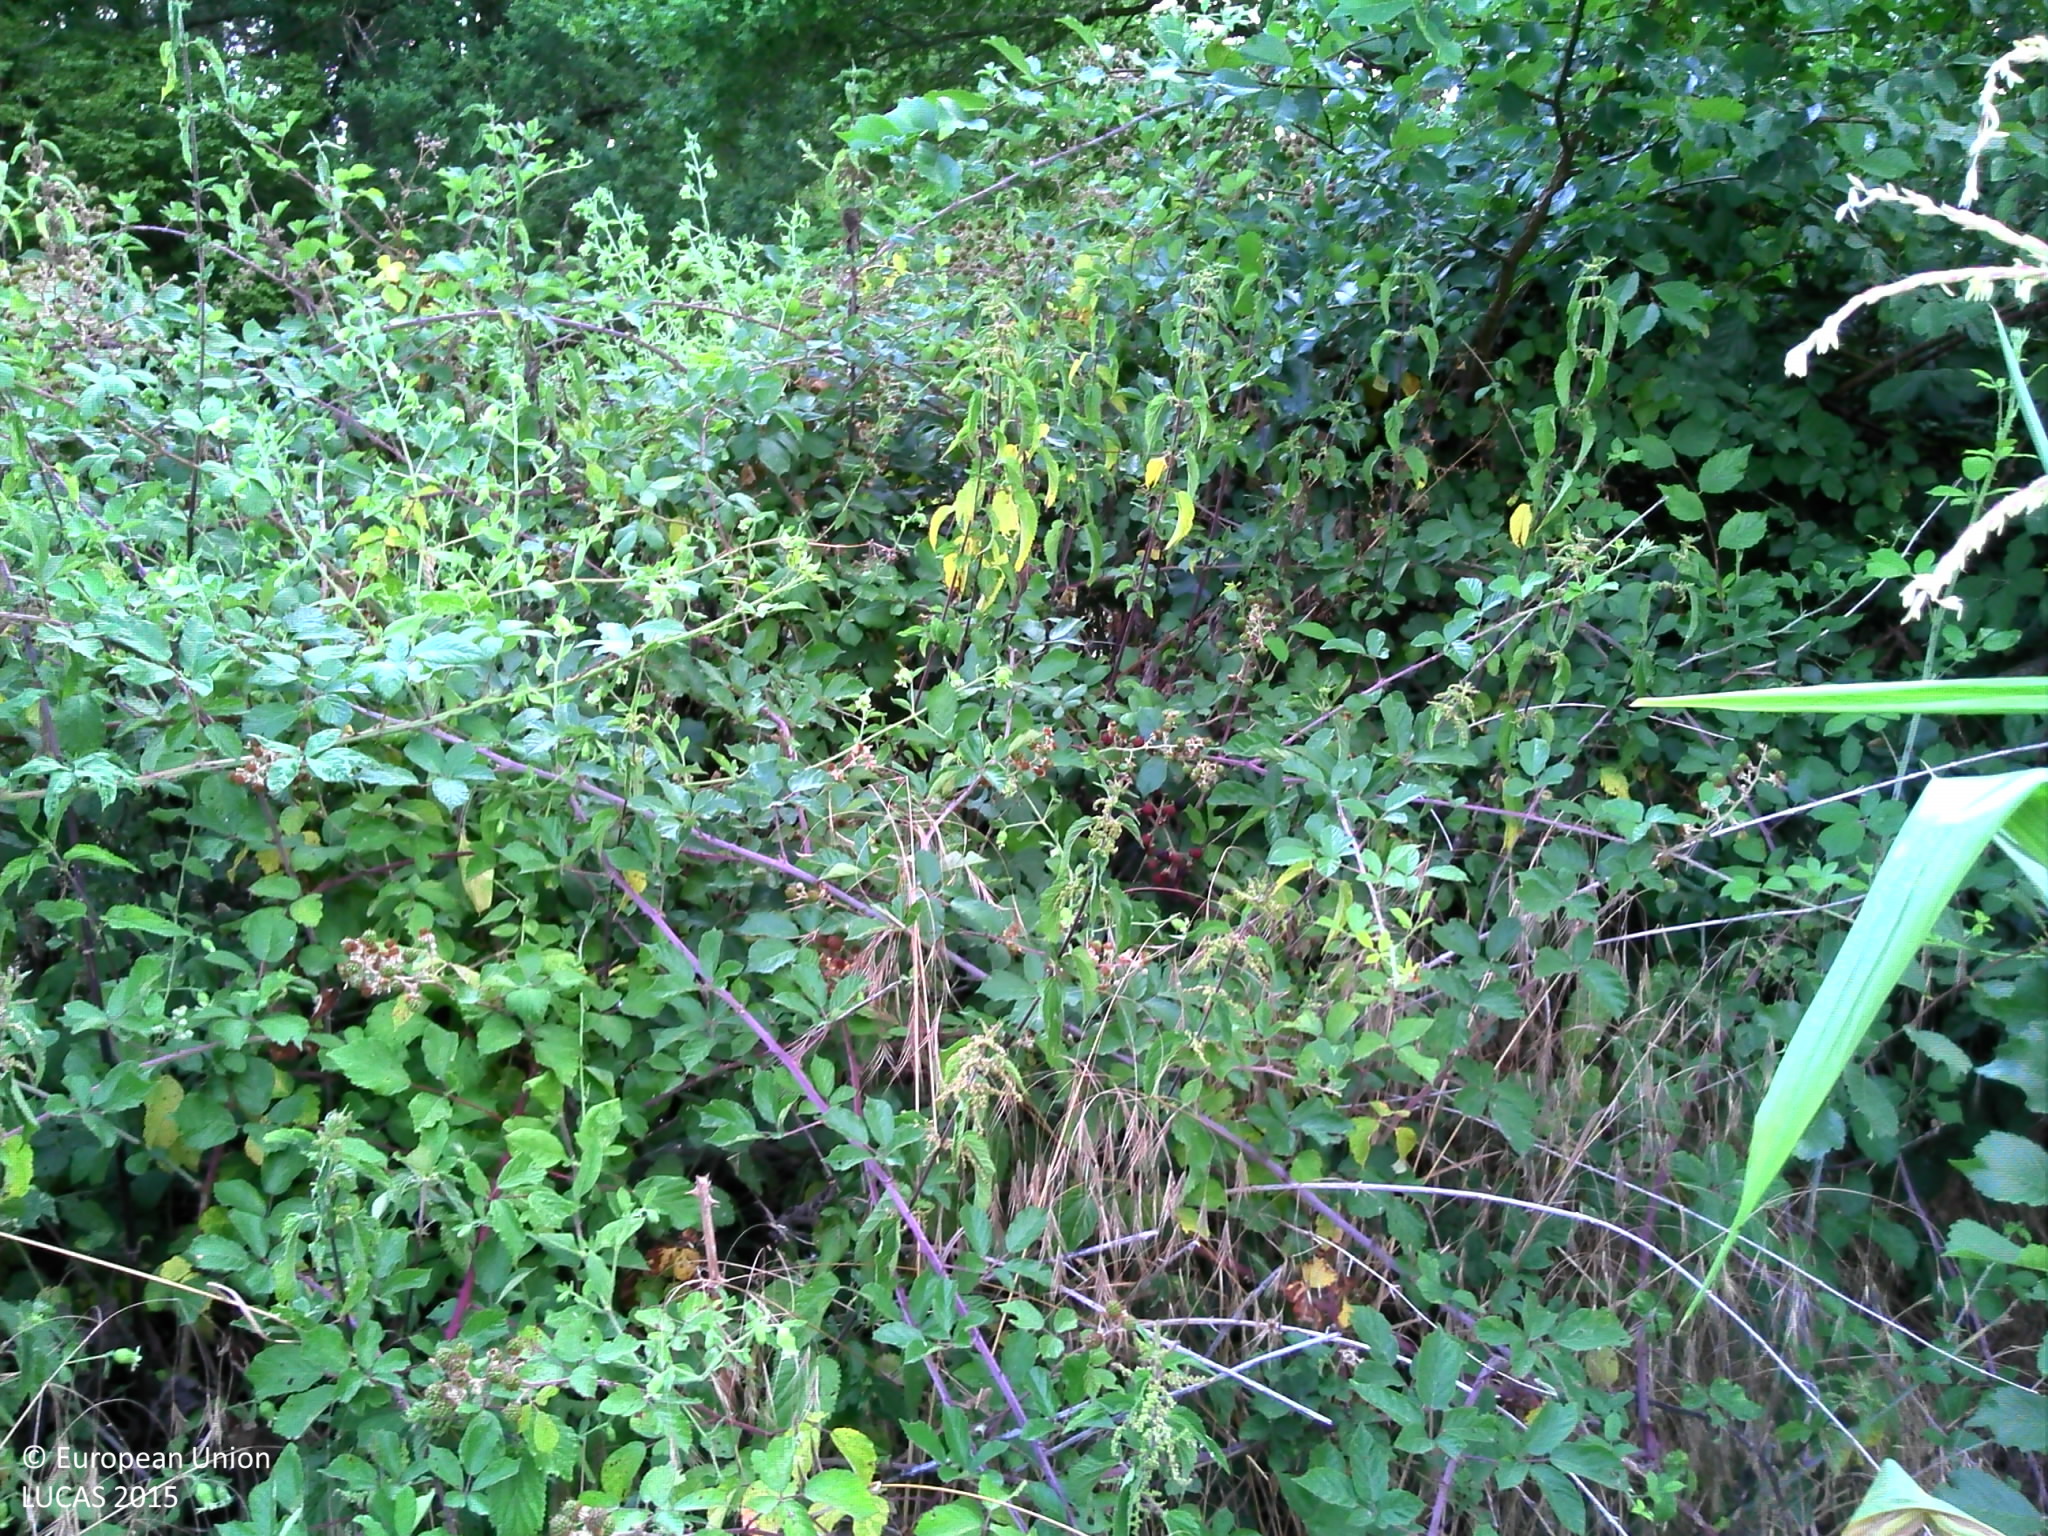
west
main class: Cropland
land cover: Maize
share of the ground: 50 - 75 %
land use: Agriculture (excluding fallow land and kitchen gardens)
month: July
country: FR
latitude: 45.1132
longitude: 0.9290
